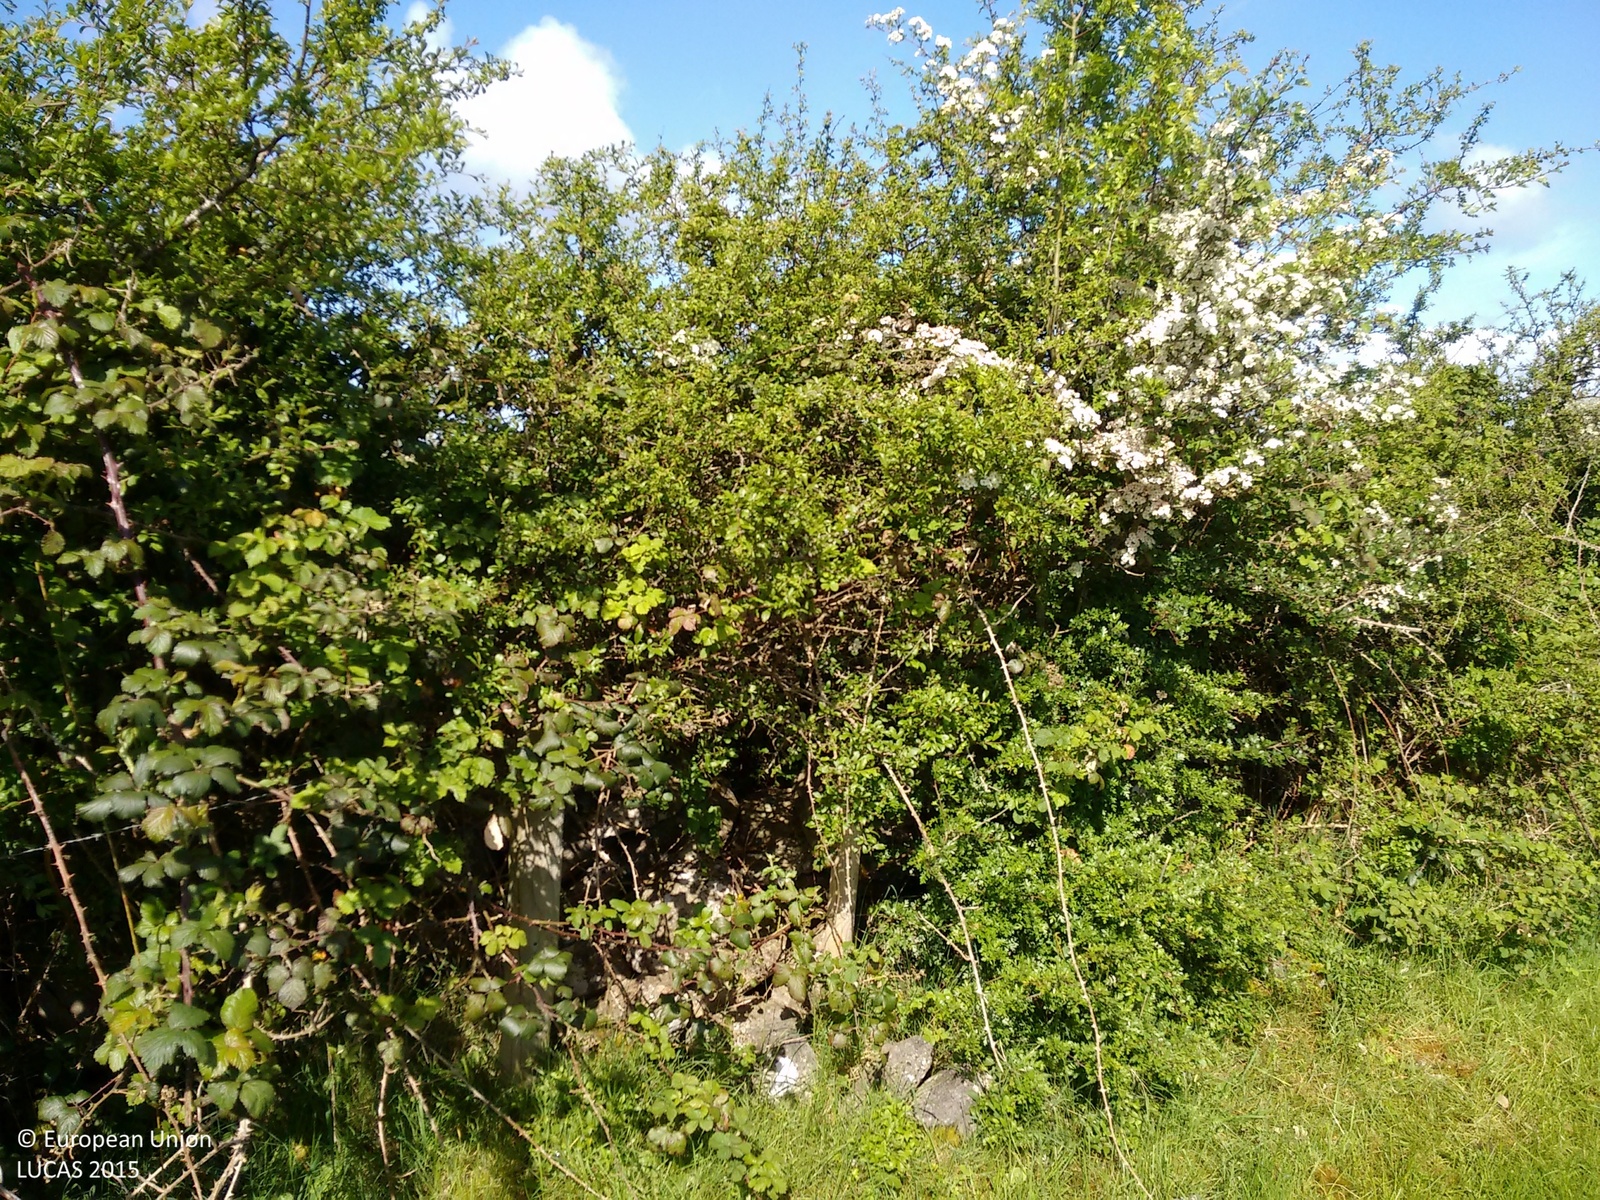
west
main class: Grassland
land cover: Grassland without tree/shrub cover
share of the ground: > 75 %
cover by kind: herbaceous plants 100 %
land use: Agriculture (excluding fallow land and kitchen gardens)
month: May
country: IE
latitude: 53.1487
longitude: -8.9144
